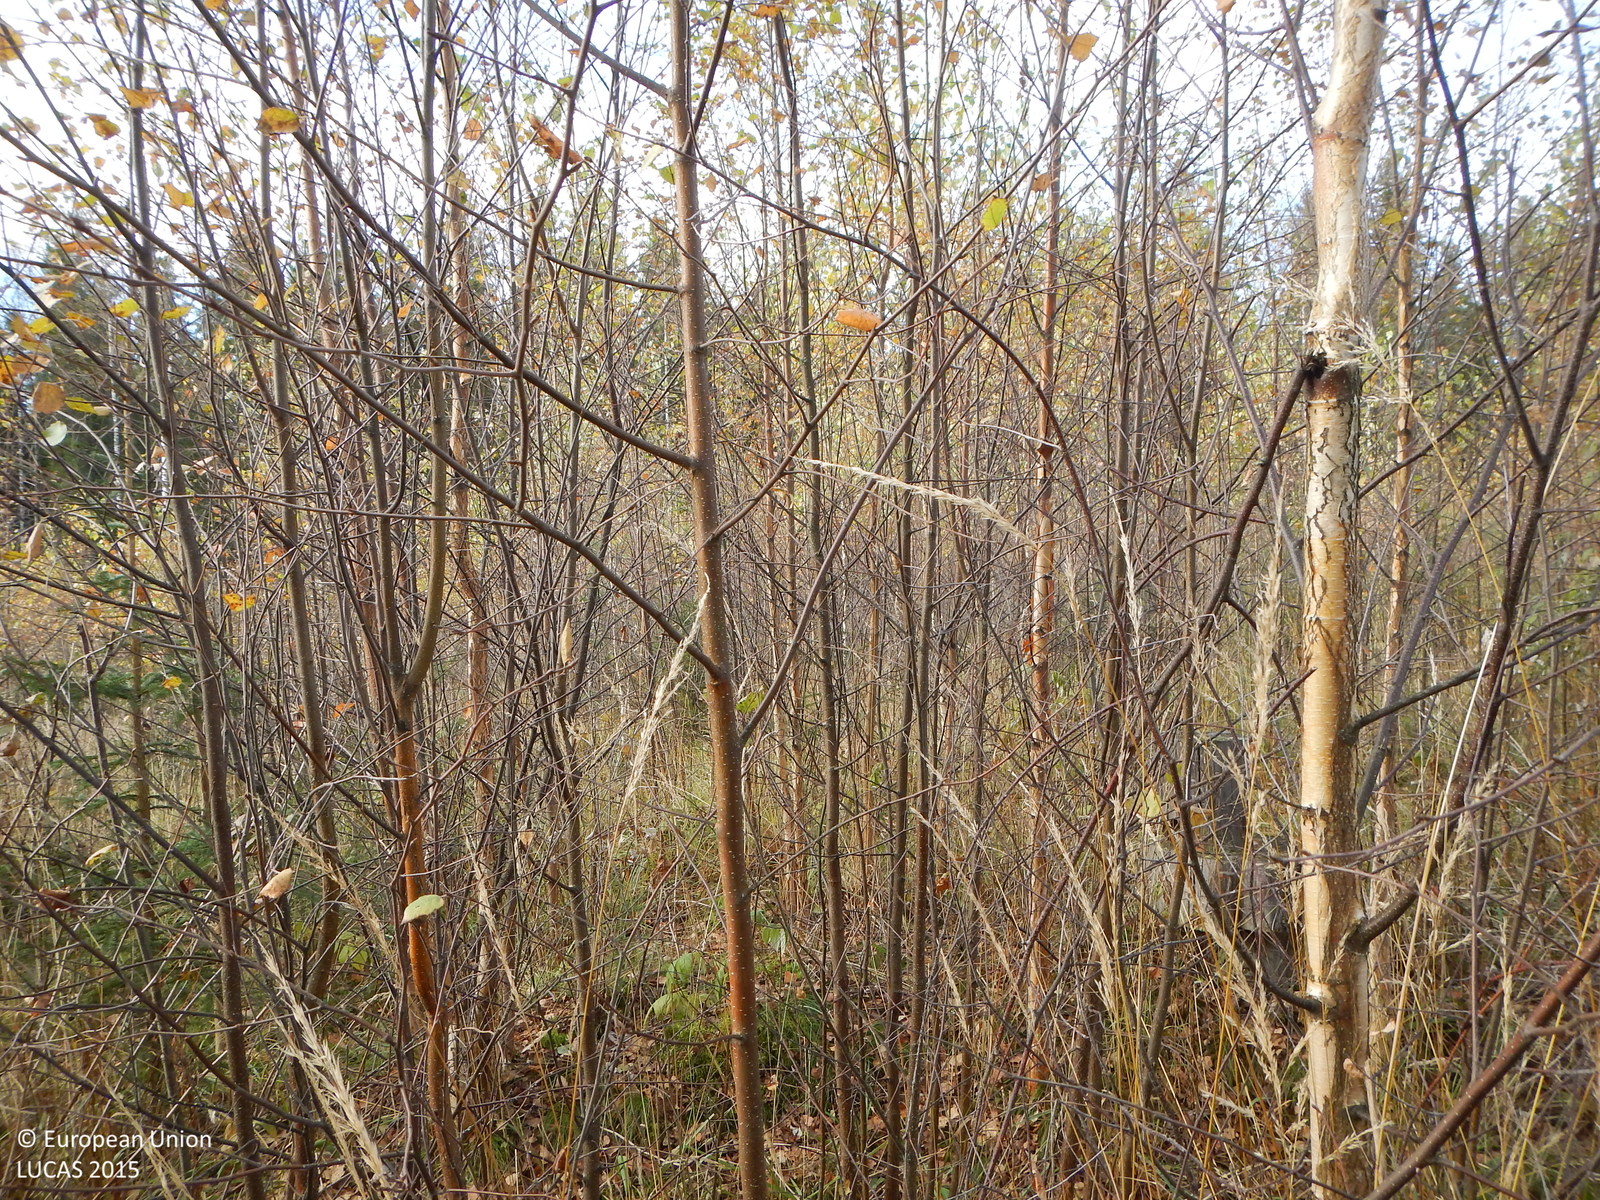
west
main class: Woodland
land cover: Broadleaved woodland
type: boreal forest
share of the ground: > 75 %
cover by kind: broadleaved forest trees 90 %, herbaceous plants 10 %
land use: Forestry
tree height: < 5 m
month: October
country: FI
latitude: 61.8495
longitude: 25.9175
